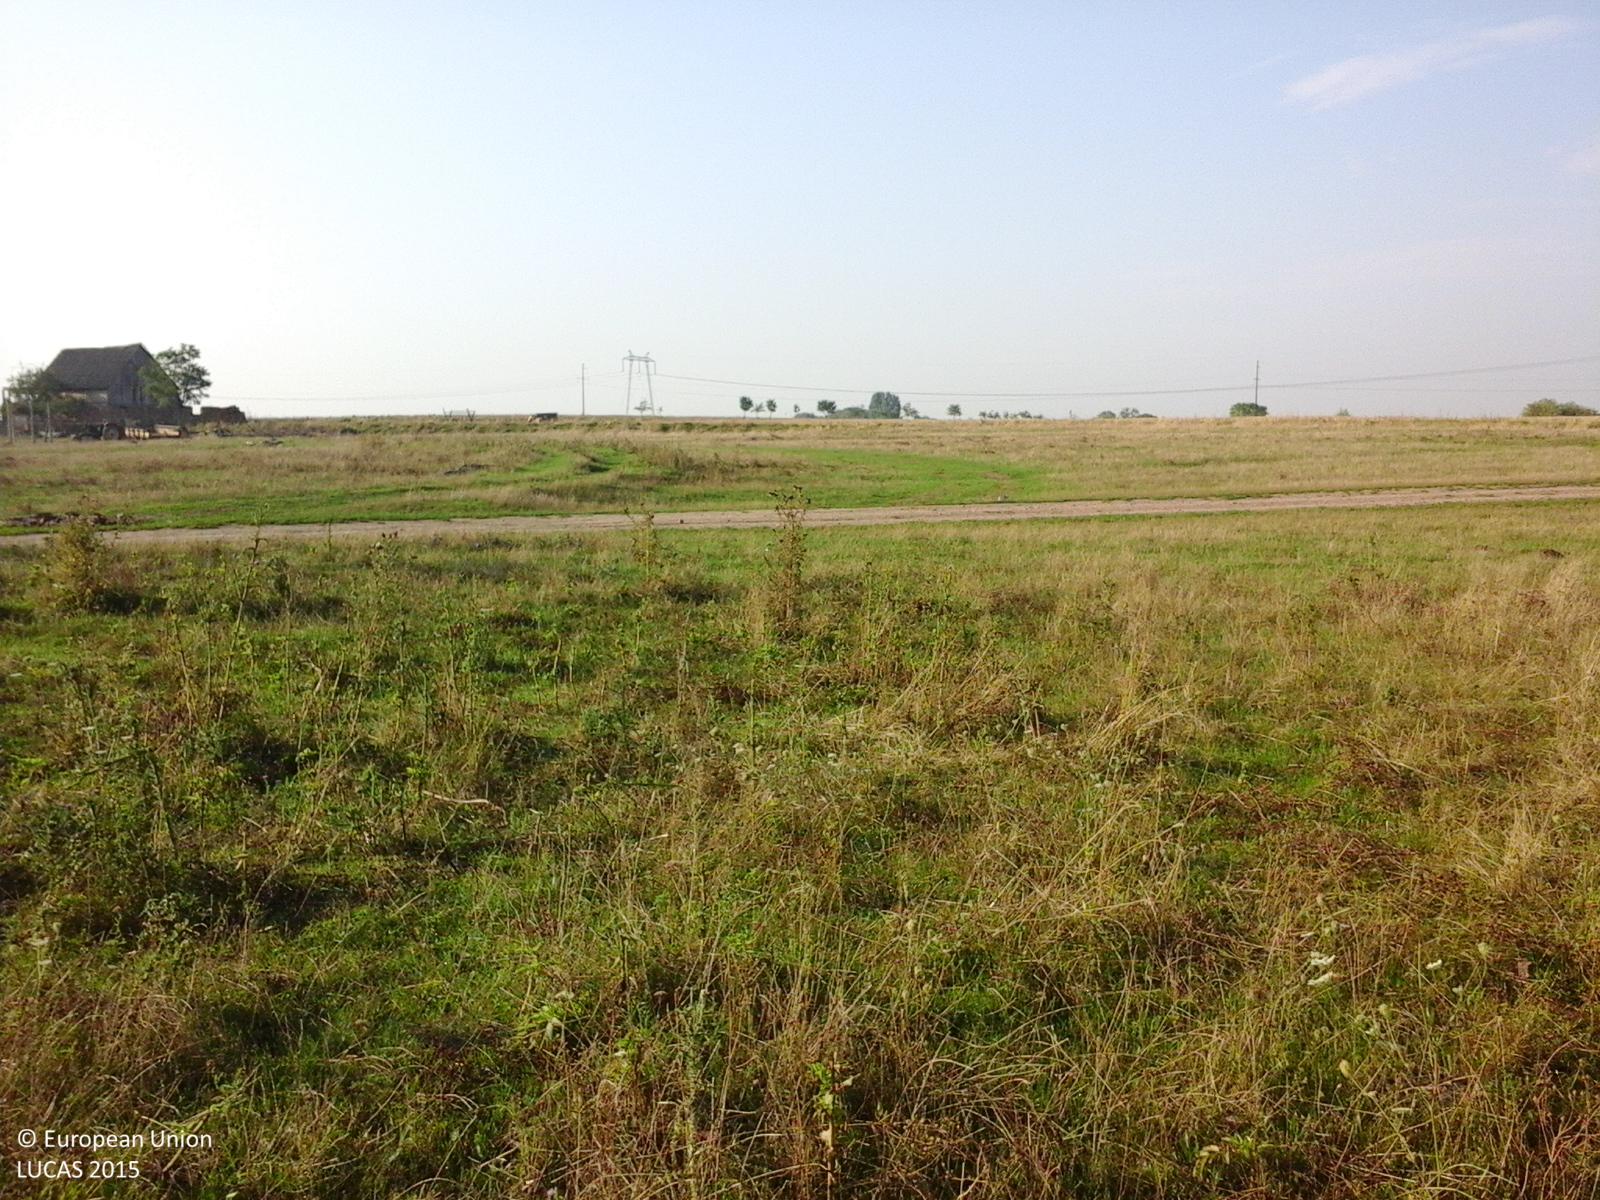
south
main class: Grassland
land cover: Grassland without tree/shrub cover
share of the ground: > 75 %
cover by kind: herbaceous plants 100 %
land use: Agriculture (excluding fallow land and kitchen gardens)
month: August
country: RO
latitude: 46.0971
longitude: 21.4568
